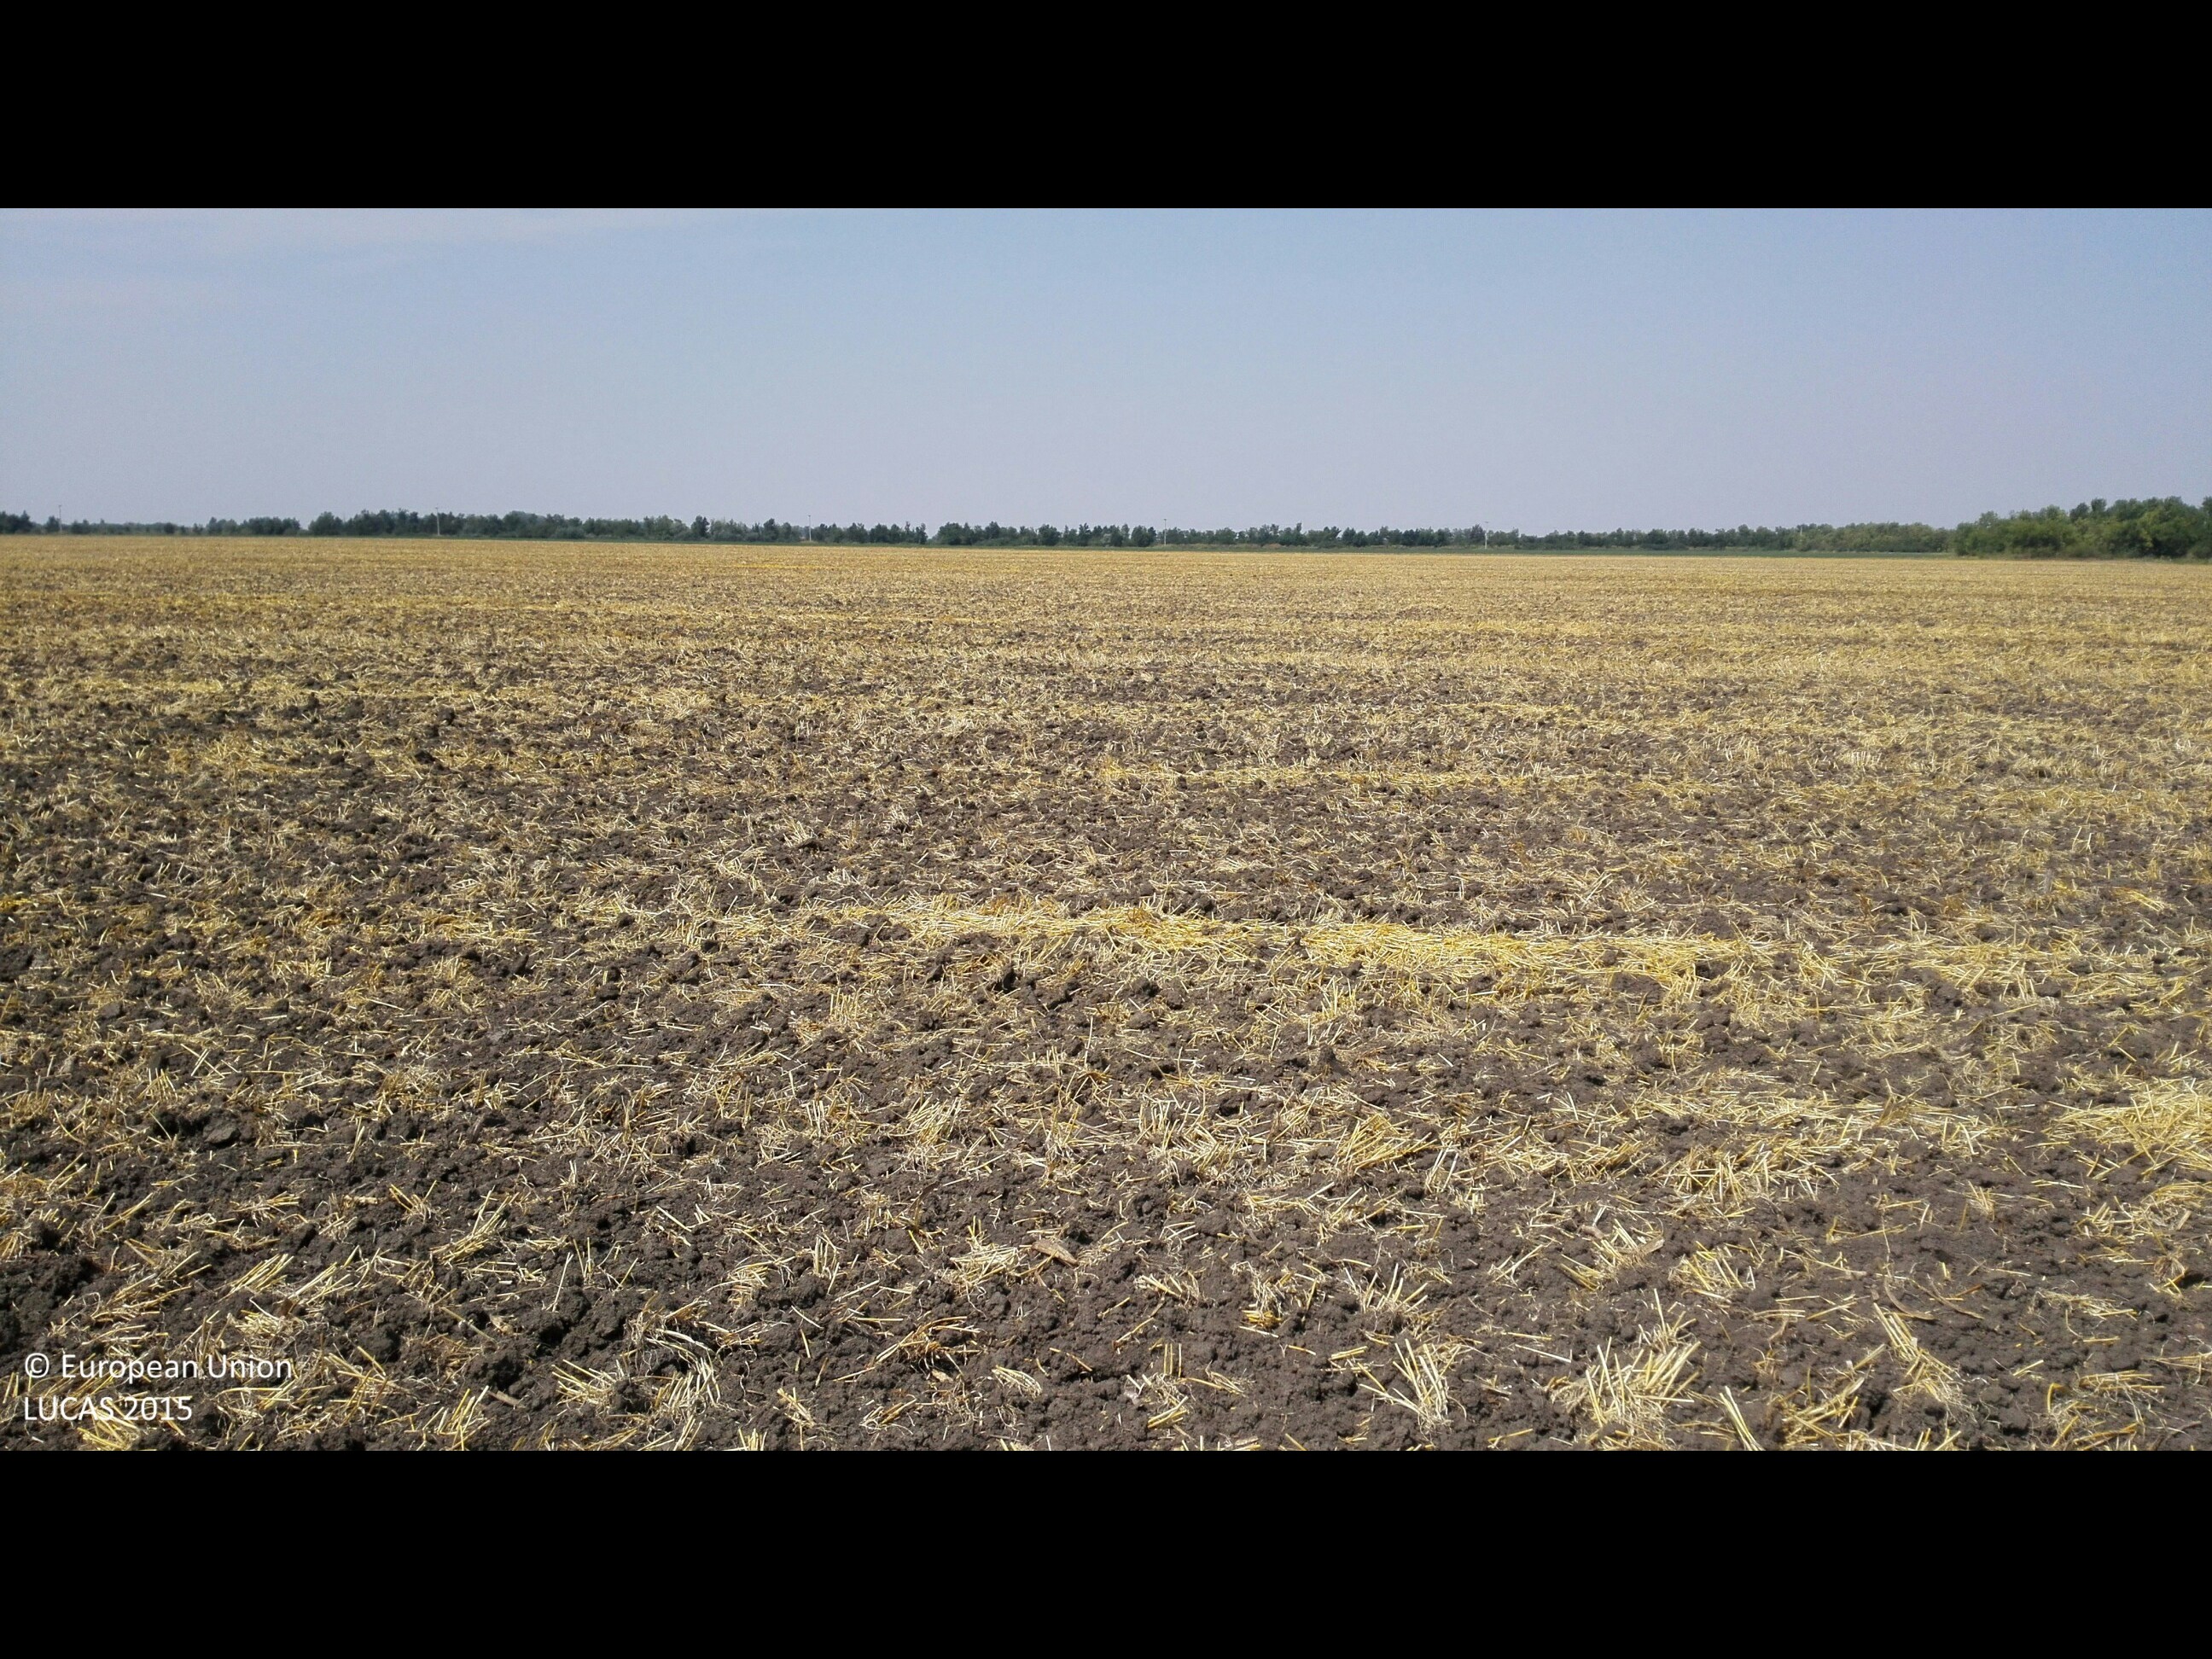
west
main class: Cropland
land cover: Common wheat
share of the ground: > 75 %
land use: Agriculture (excluding fallow land and kitchen gardens)
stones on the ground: < 10 %
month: July
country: HU
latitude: 47.1921
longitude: 21.2436
